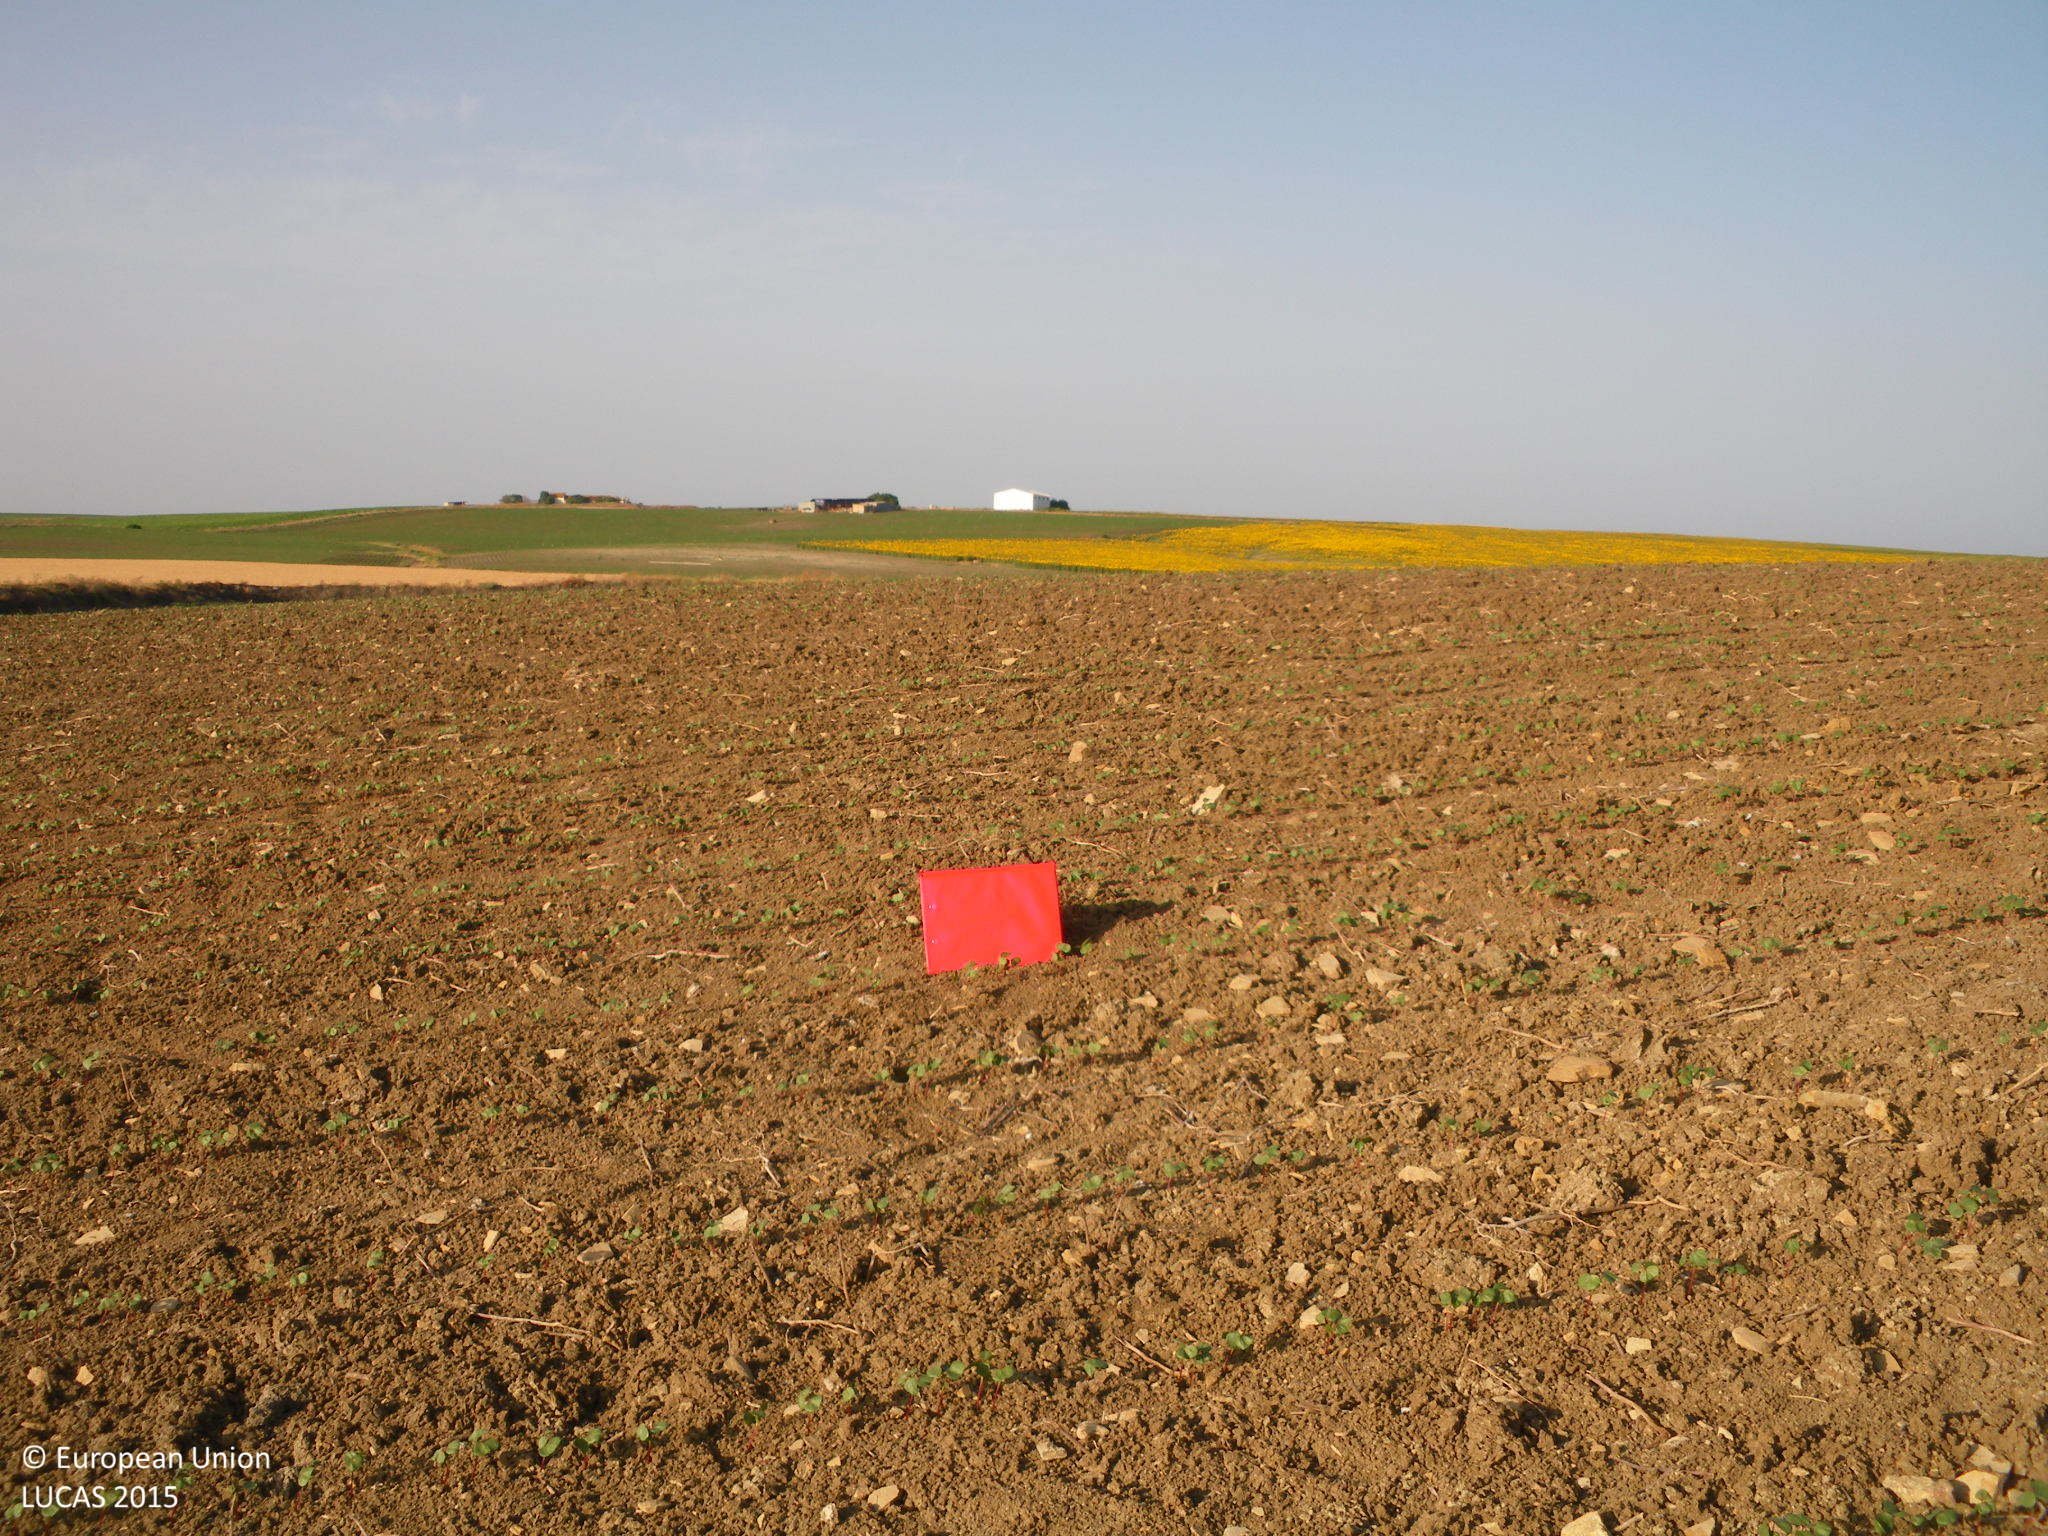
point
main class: Cropland
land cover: Cotton
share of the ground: < 10 %
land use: Agriculture (excluding fallow land and kitchen gardens)
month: June
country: ES
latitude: 36.6466
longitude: -6.2888
